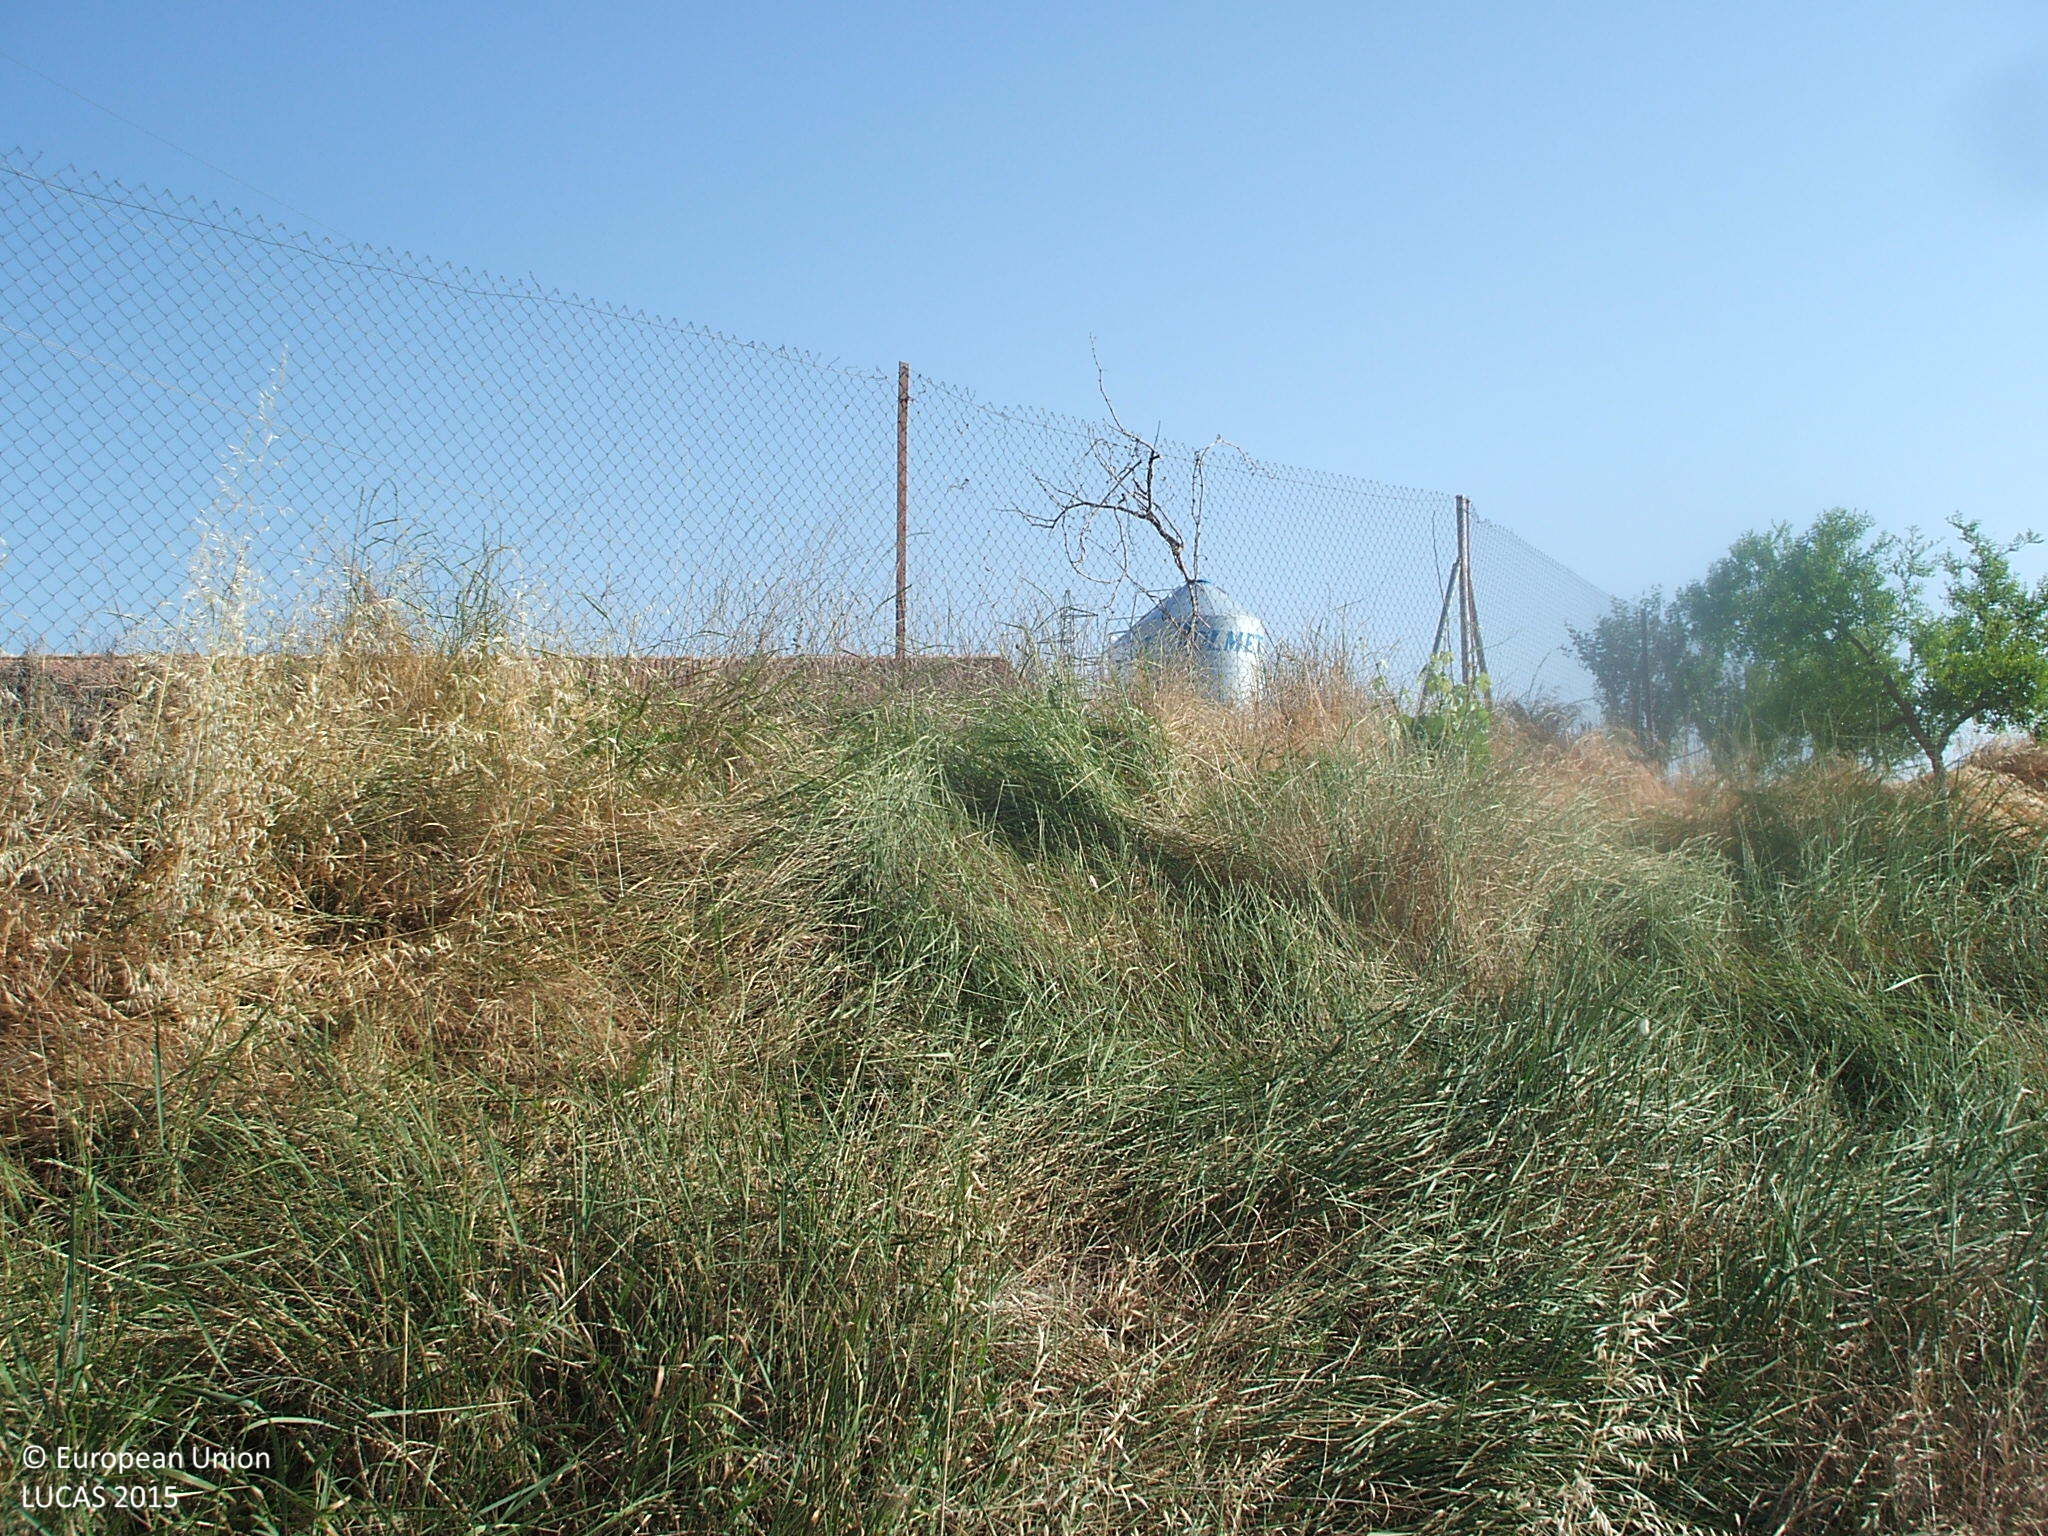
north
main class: Grassland
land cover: Grassland with sparse tree/shrub cover
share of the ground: > 75 %
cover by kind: herbaceous plants 95 %, broadleaved forest trees 5 %
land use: Semi-natural and natural areas not in use
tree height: < 5 m
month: June
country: ES
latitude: 40.8409
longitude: -0.2453
